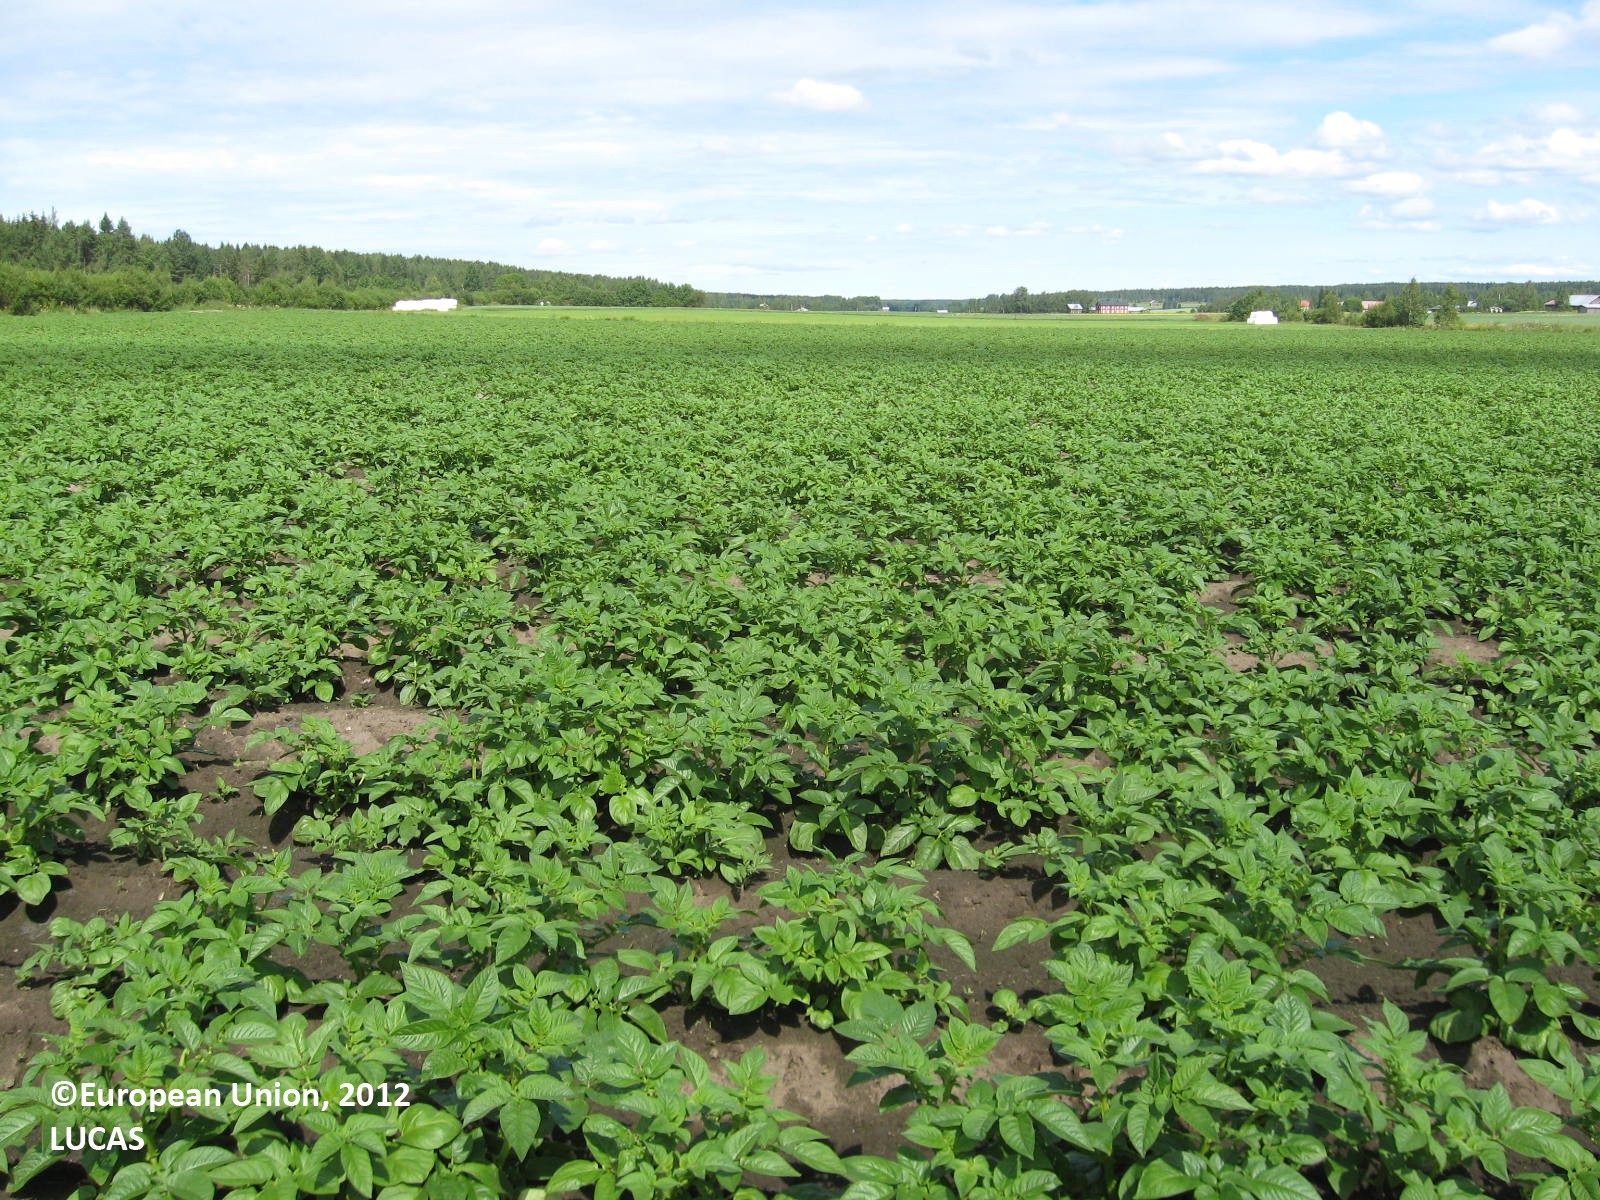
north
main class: Cropland
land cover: Potatoes
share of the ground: 50 - 75 %
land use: Agriculture (excluding fallow land and kitchen gardens)
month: July
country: FI
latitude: 62.3854
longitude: 21.5511
